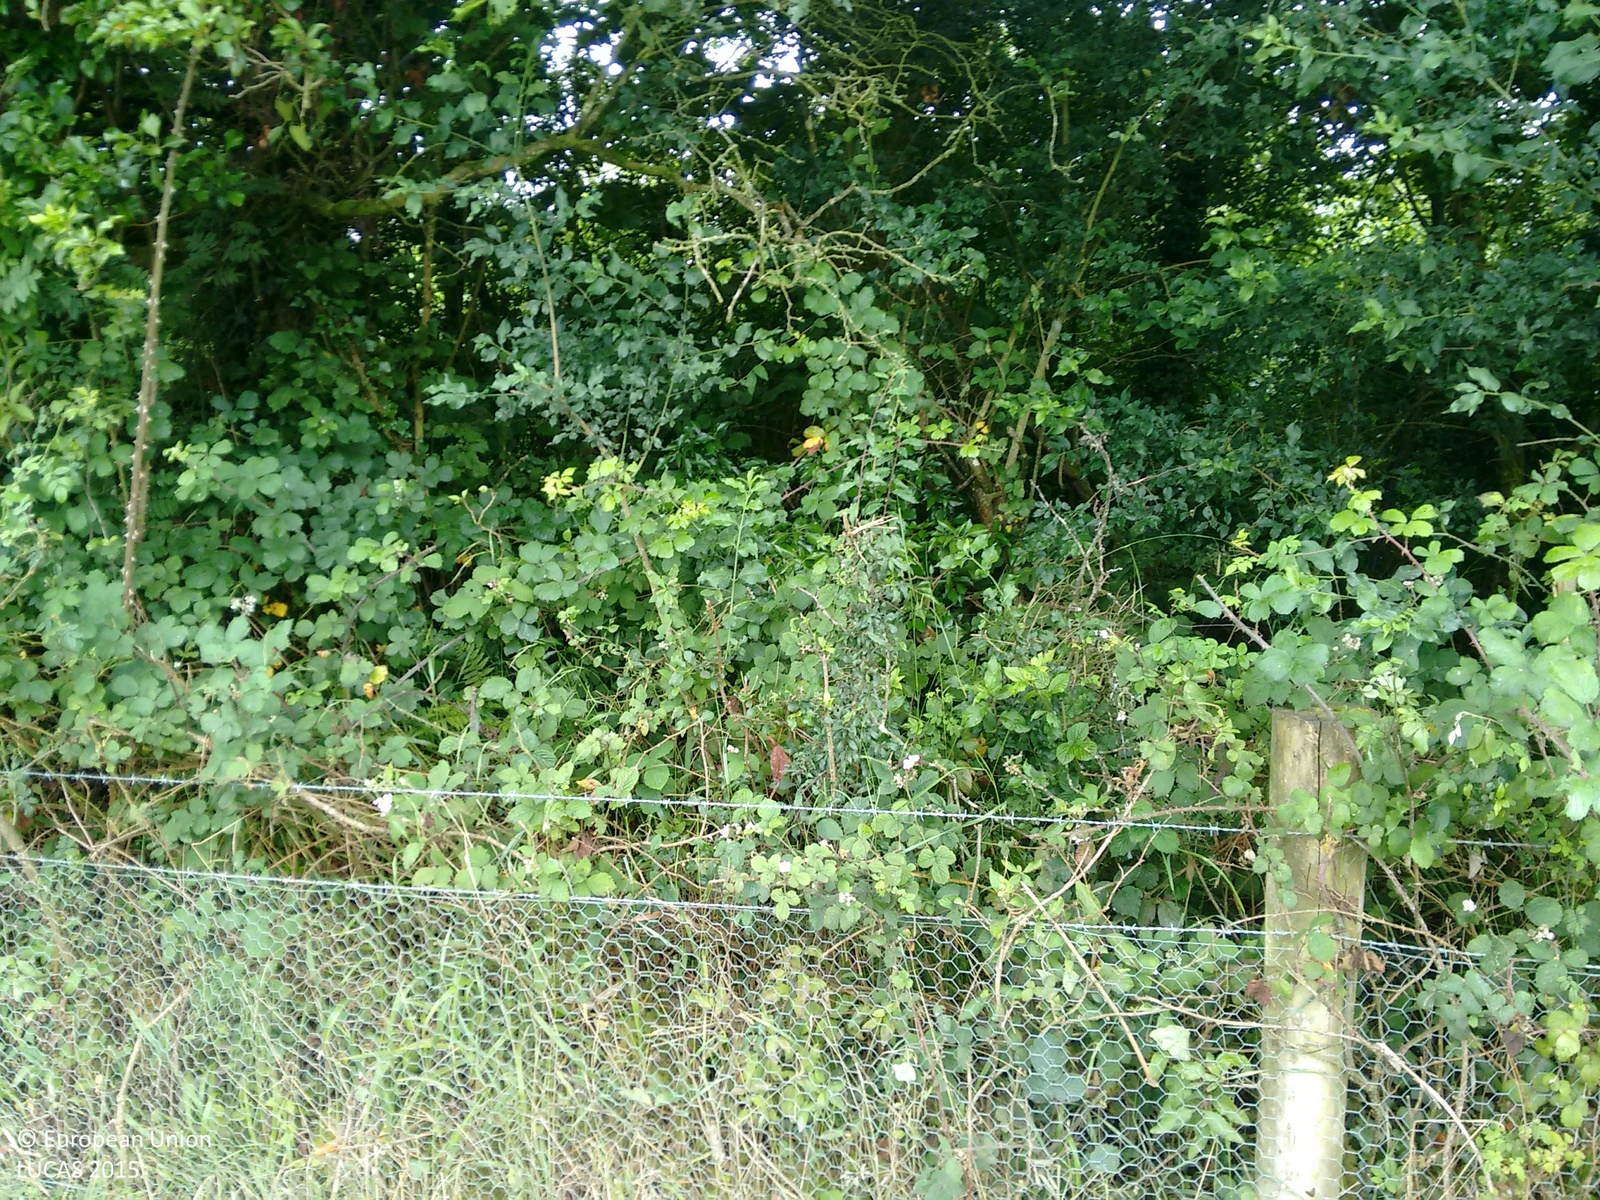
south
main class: Grassland
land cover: Grassland without tree/shrub cover
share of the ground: > 75 %
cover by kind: herbaceous plants 100 %
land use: Agriculture (excluding fallow land and kitchen gardens)
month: July
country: IE
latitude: 52.6171
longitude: -7.4532
